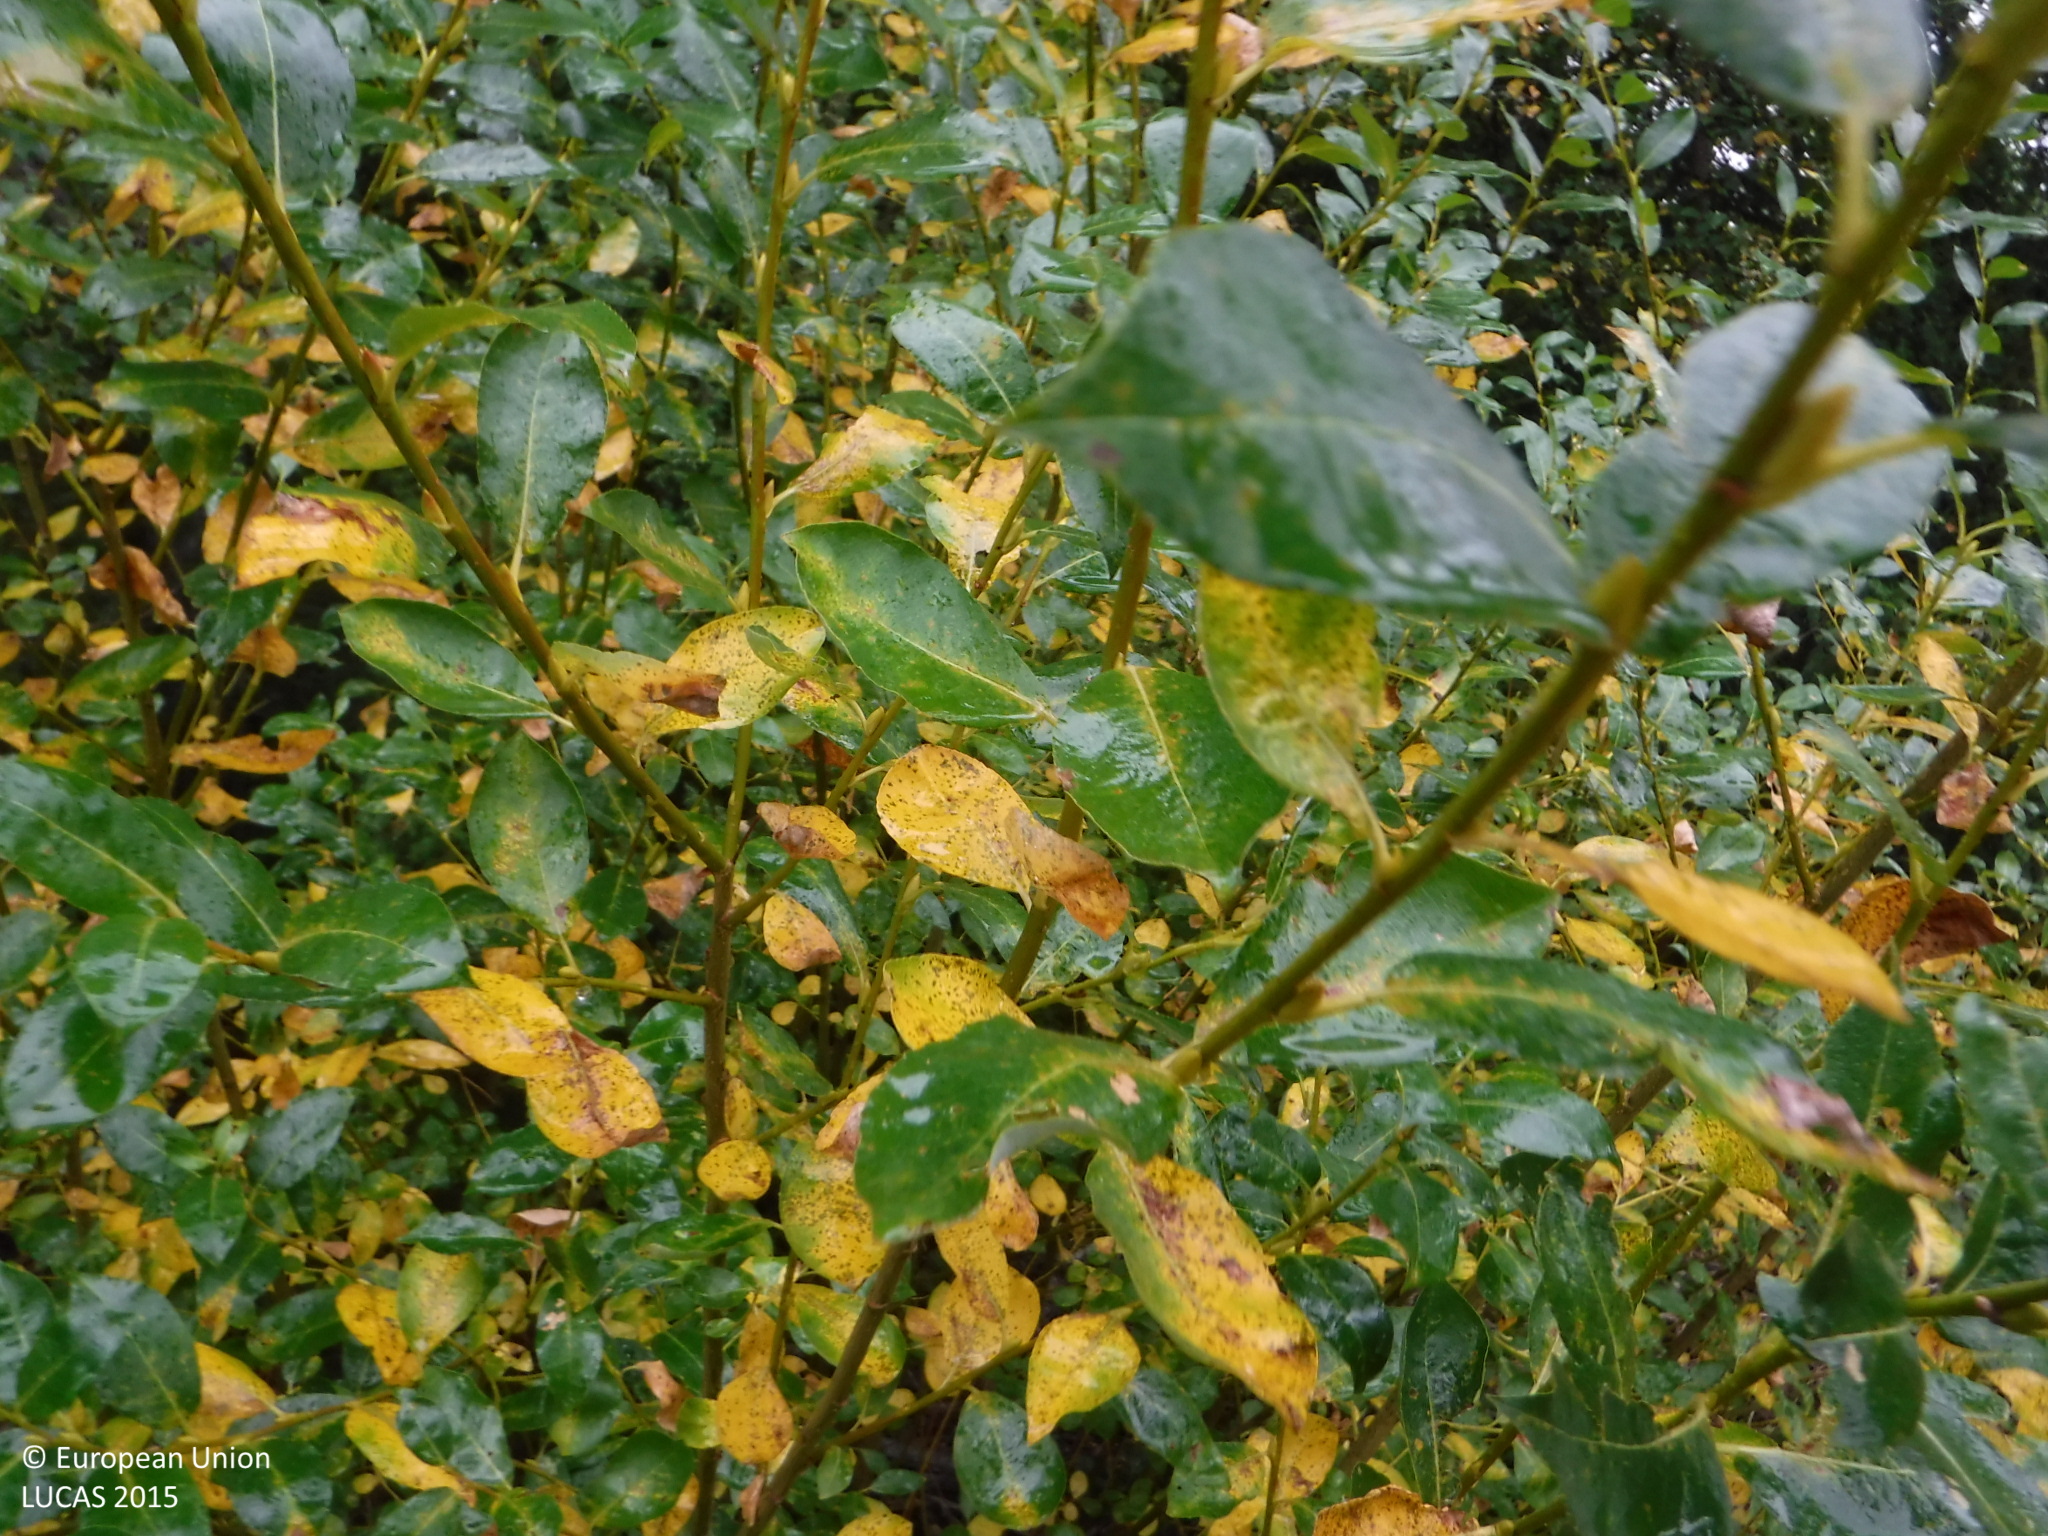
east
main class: Cropland
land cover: Oats
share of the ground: > 75 %
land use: Agriculture (excluding fallow land and kitchen gardens)
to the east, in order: Oats; Groves; Other mixed woodland; Tracks; Broadleaved woodland; Tracks; Broadleaved woodland; Other mixed woodland
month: August
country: FI
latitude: 61.2625
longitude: 22.9556
